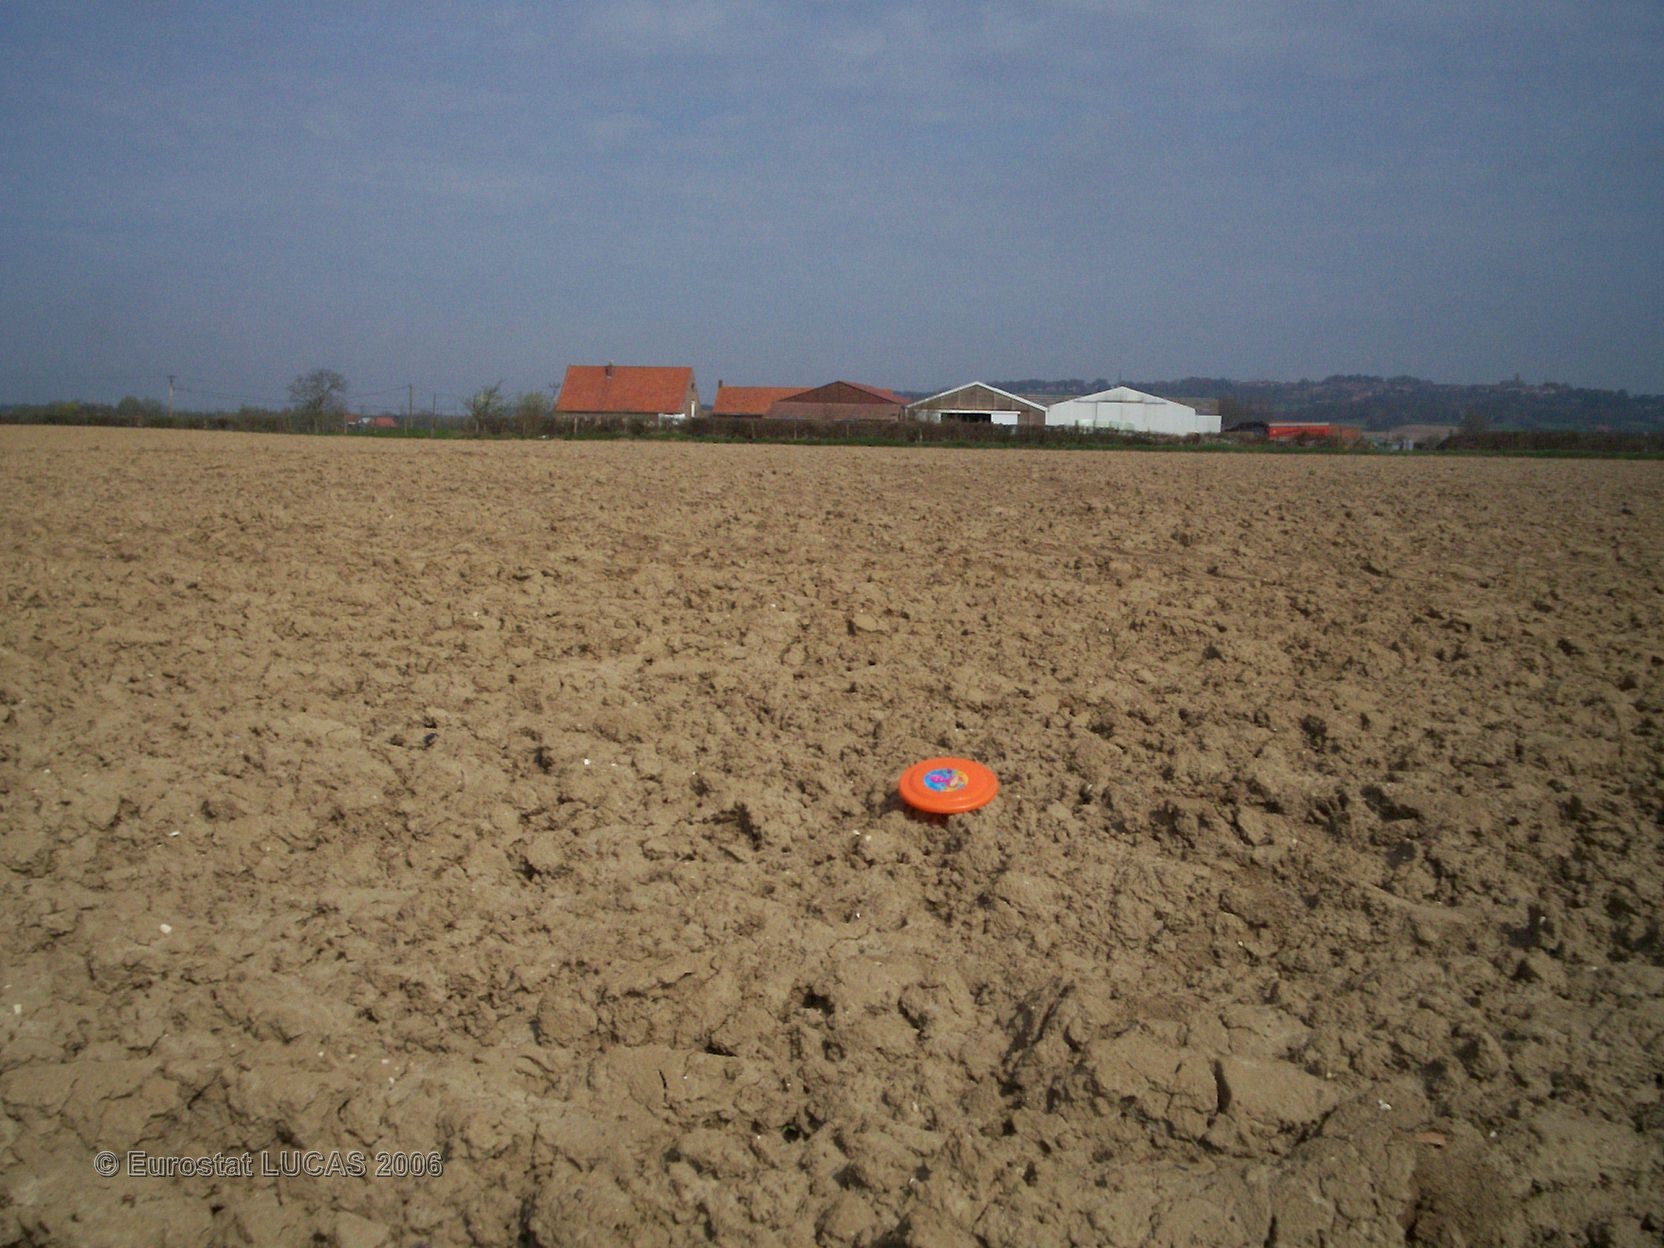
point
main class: Cropland
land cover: Potatoes
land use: Agriculture (excluding fallow land and kitchen gardens)
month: May
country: FR
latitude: 50.7669
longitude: 2.4867
